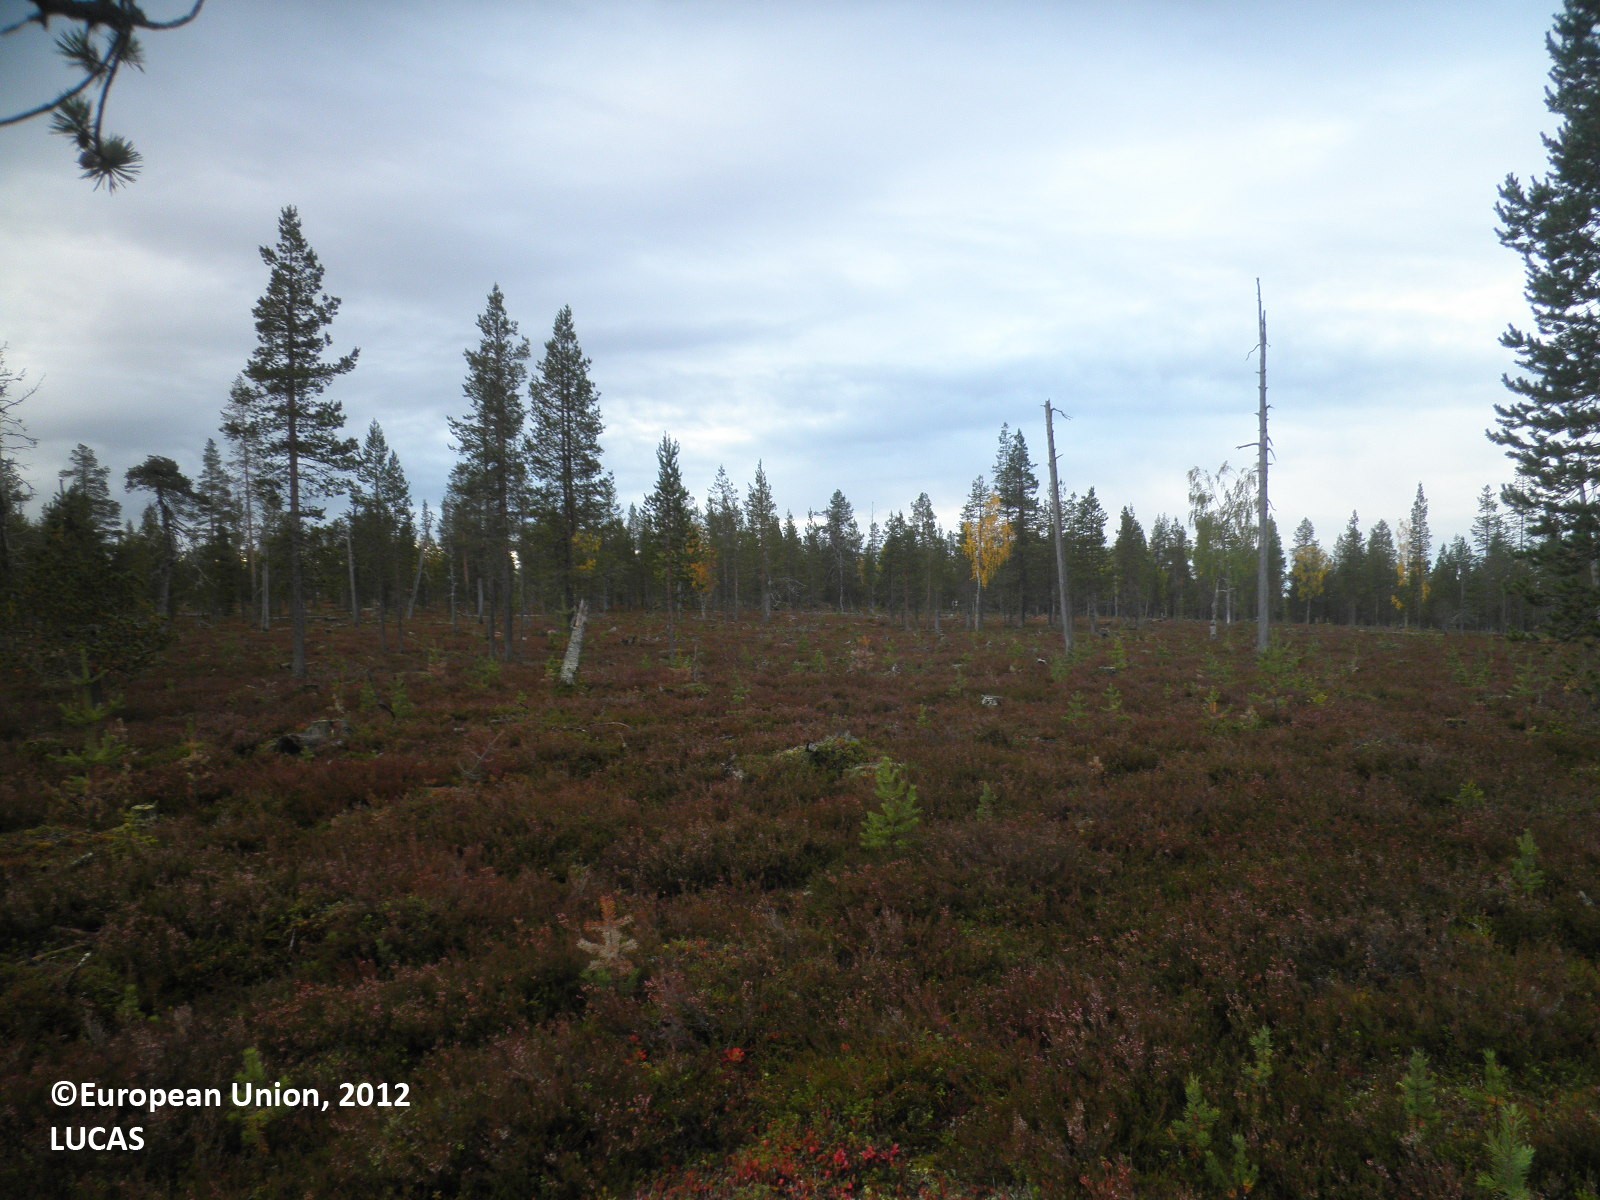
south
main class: Shrubland
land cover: Shrubland with sparse tree cover
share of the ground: > 75 %
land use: Forestry
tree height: > 5 m
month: September
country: FI
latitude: 67.7145
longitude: 28.4846
